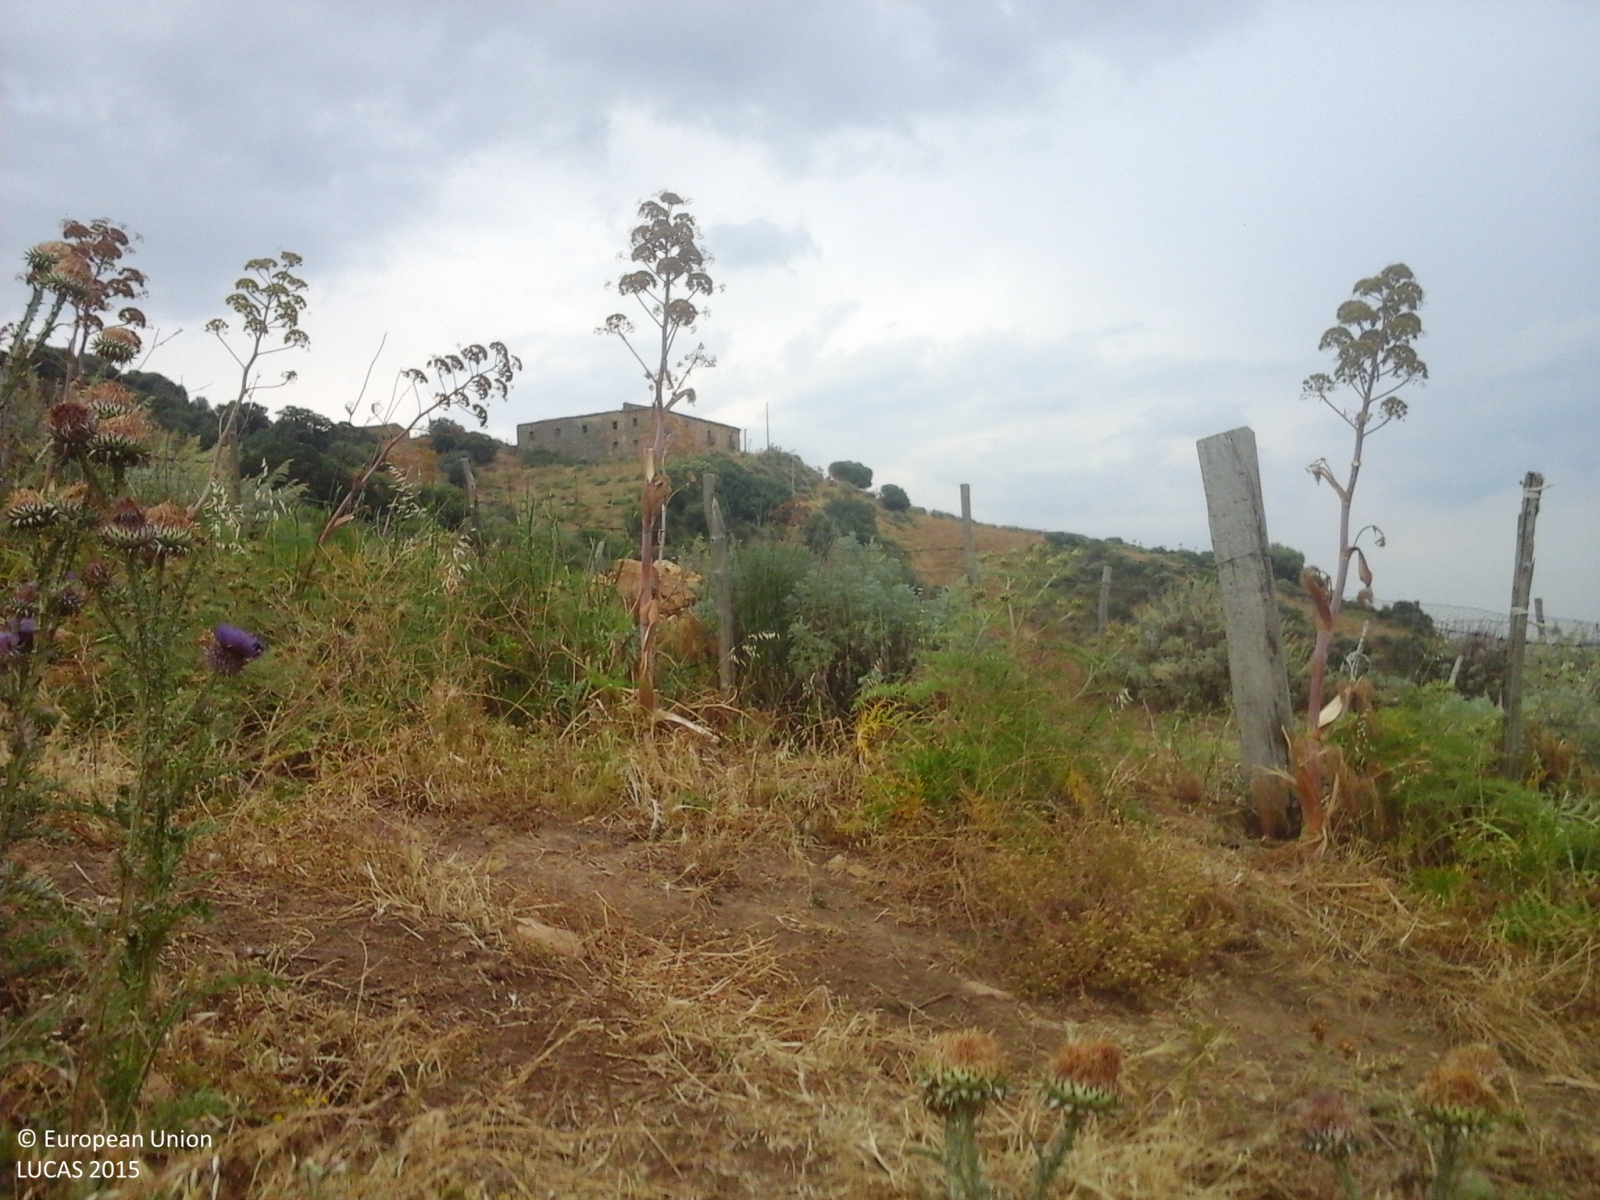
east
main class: Grassland
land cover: Grassland with sparse tree/shrub cover
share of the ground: > 75 %
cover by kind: herbaceous plants 75 %, unconsolidated bare surface 15 %, broadleaved forest trees 5 %, shrubs 5 %
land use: Agriculture (excluding fallow land and kitchen gardens)
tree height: < 5 m
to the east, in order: Grassland with sparse tree/shrub cover; Tracks; Grass margins; Fences; Grass margins; Tracks; Fences; Grass margins; Temporary grasslands; Grass margins; Fences; Broadleaved woodland; Fences; Grassland with sparse tree/shrub cover; Ditches and canals; Grassland with sparse tree/shrub cover; Tracks; Shrubland without tree cover
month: June
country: IT
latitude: 37.7150
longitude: 14.4718
